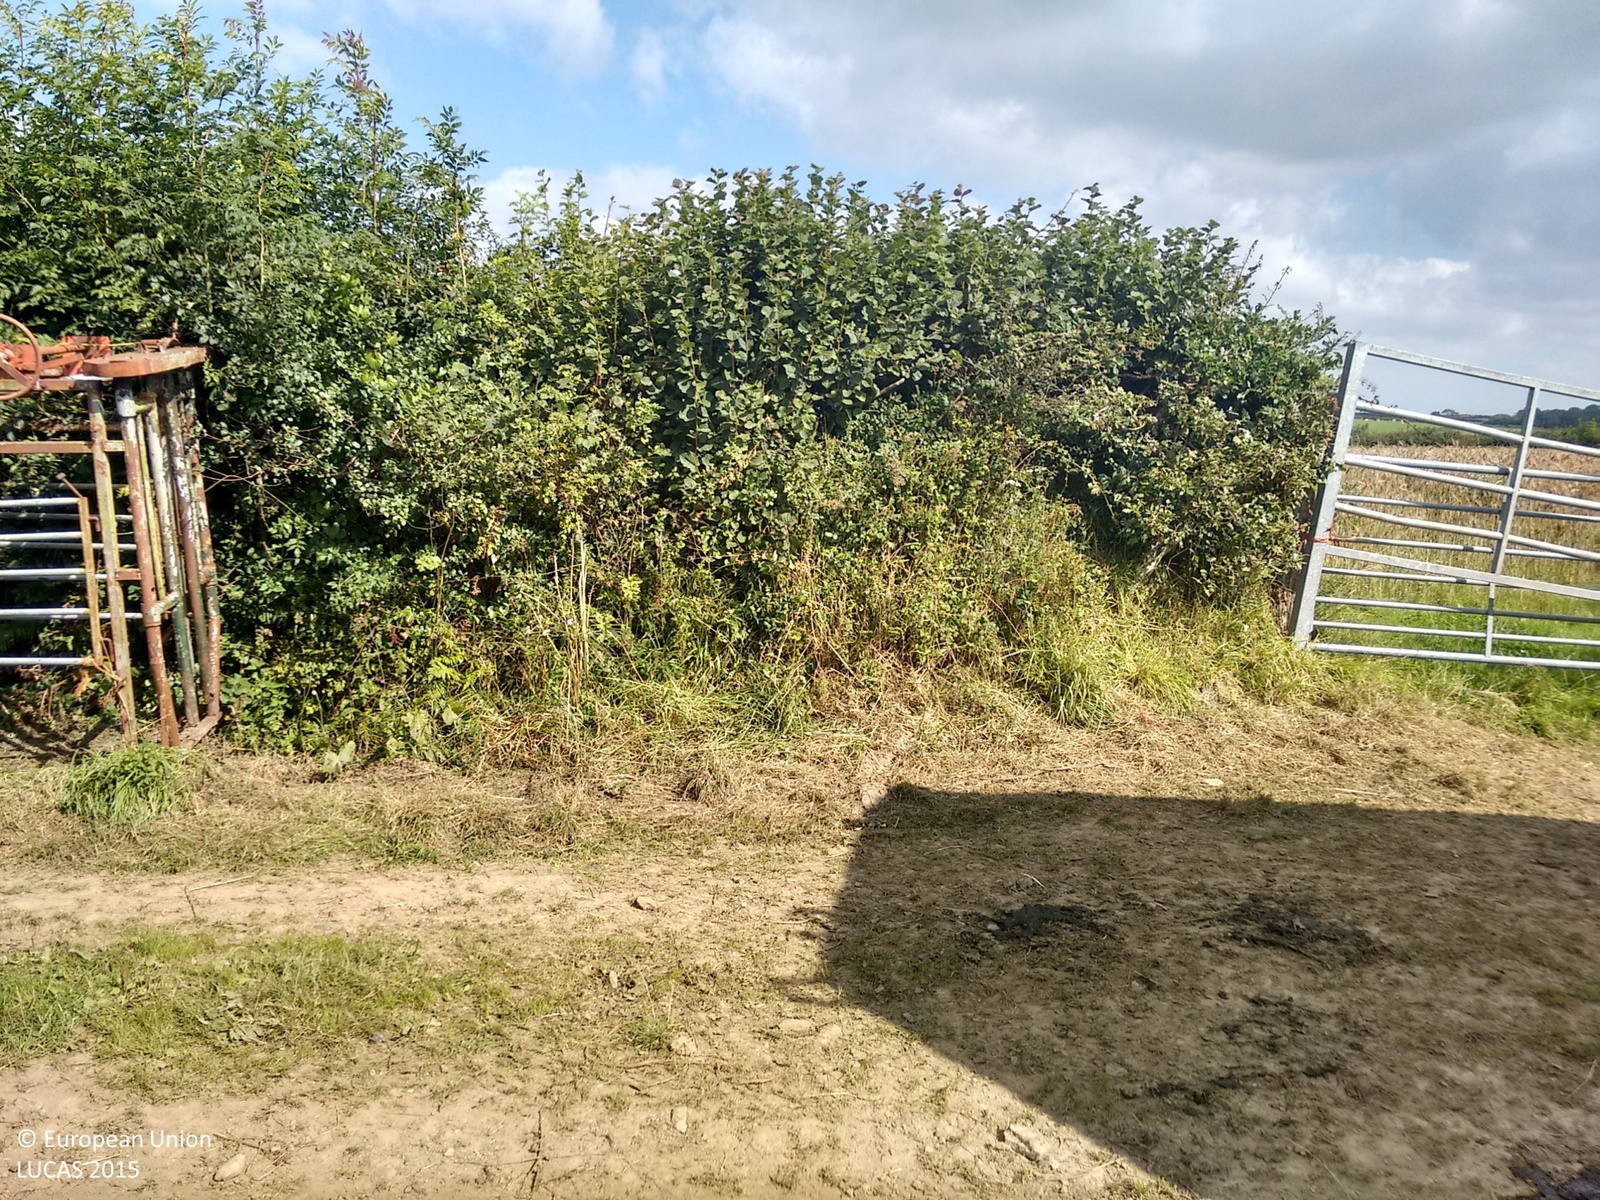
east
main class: Cropland
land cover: Barley
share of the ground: > 75 %
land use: Agriculture (excluding fallow land and kitchen gardens)
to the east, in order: Barley; Grass margins; Managed hedges; Tracks; Grass margins; Managed hedges; Grass margins; Barley
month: September
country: GB
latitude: 50.9193
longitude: -4.1662
